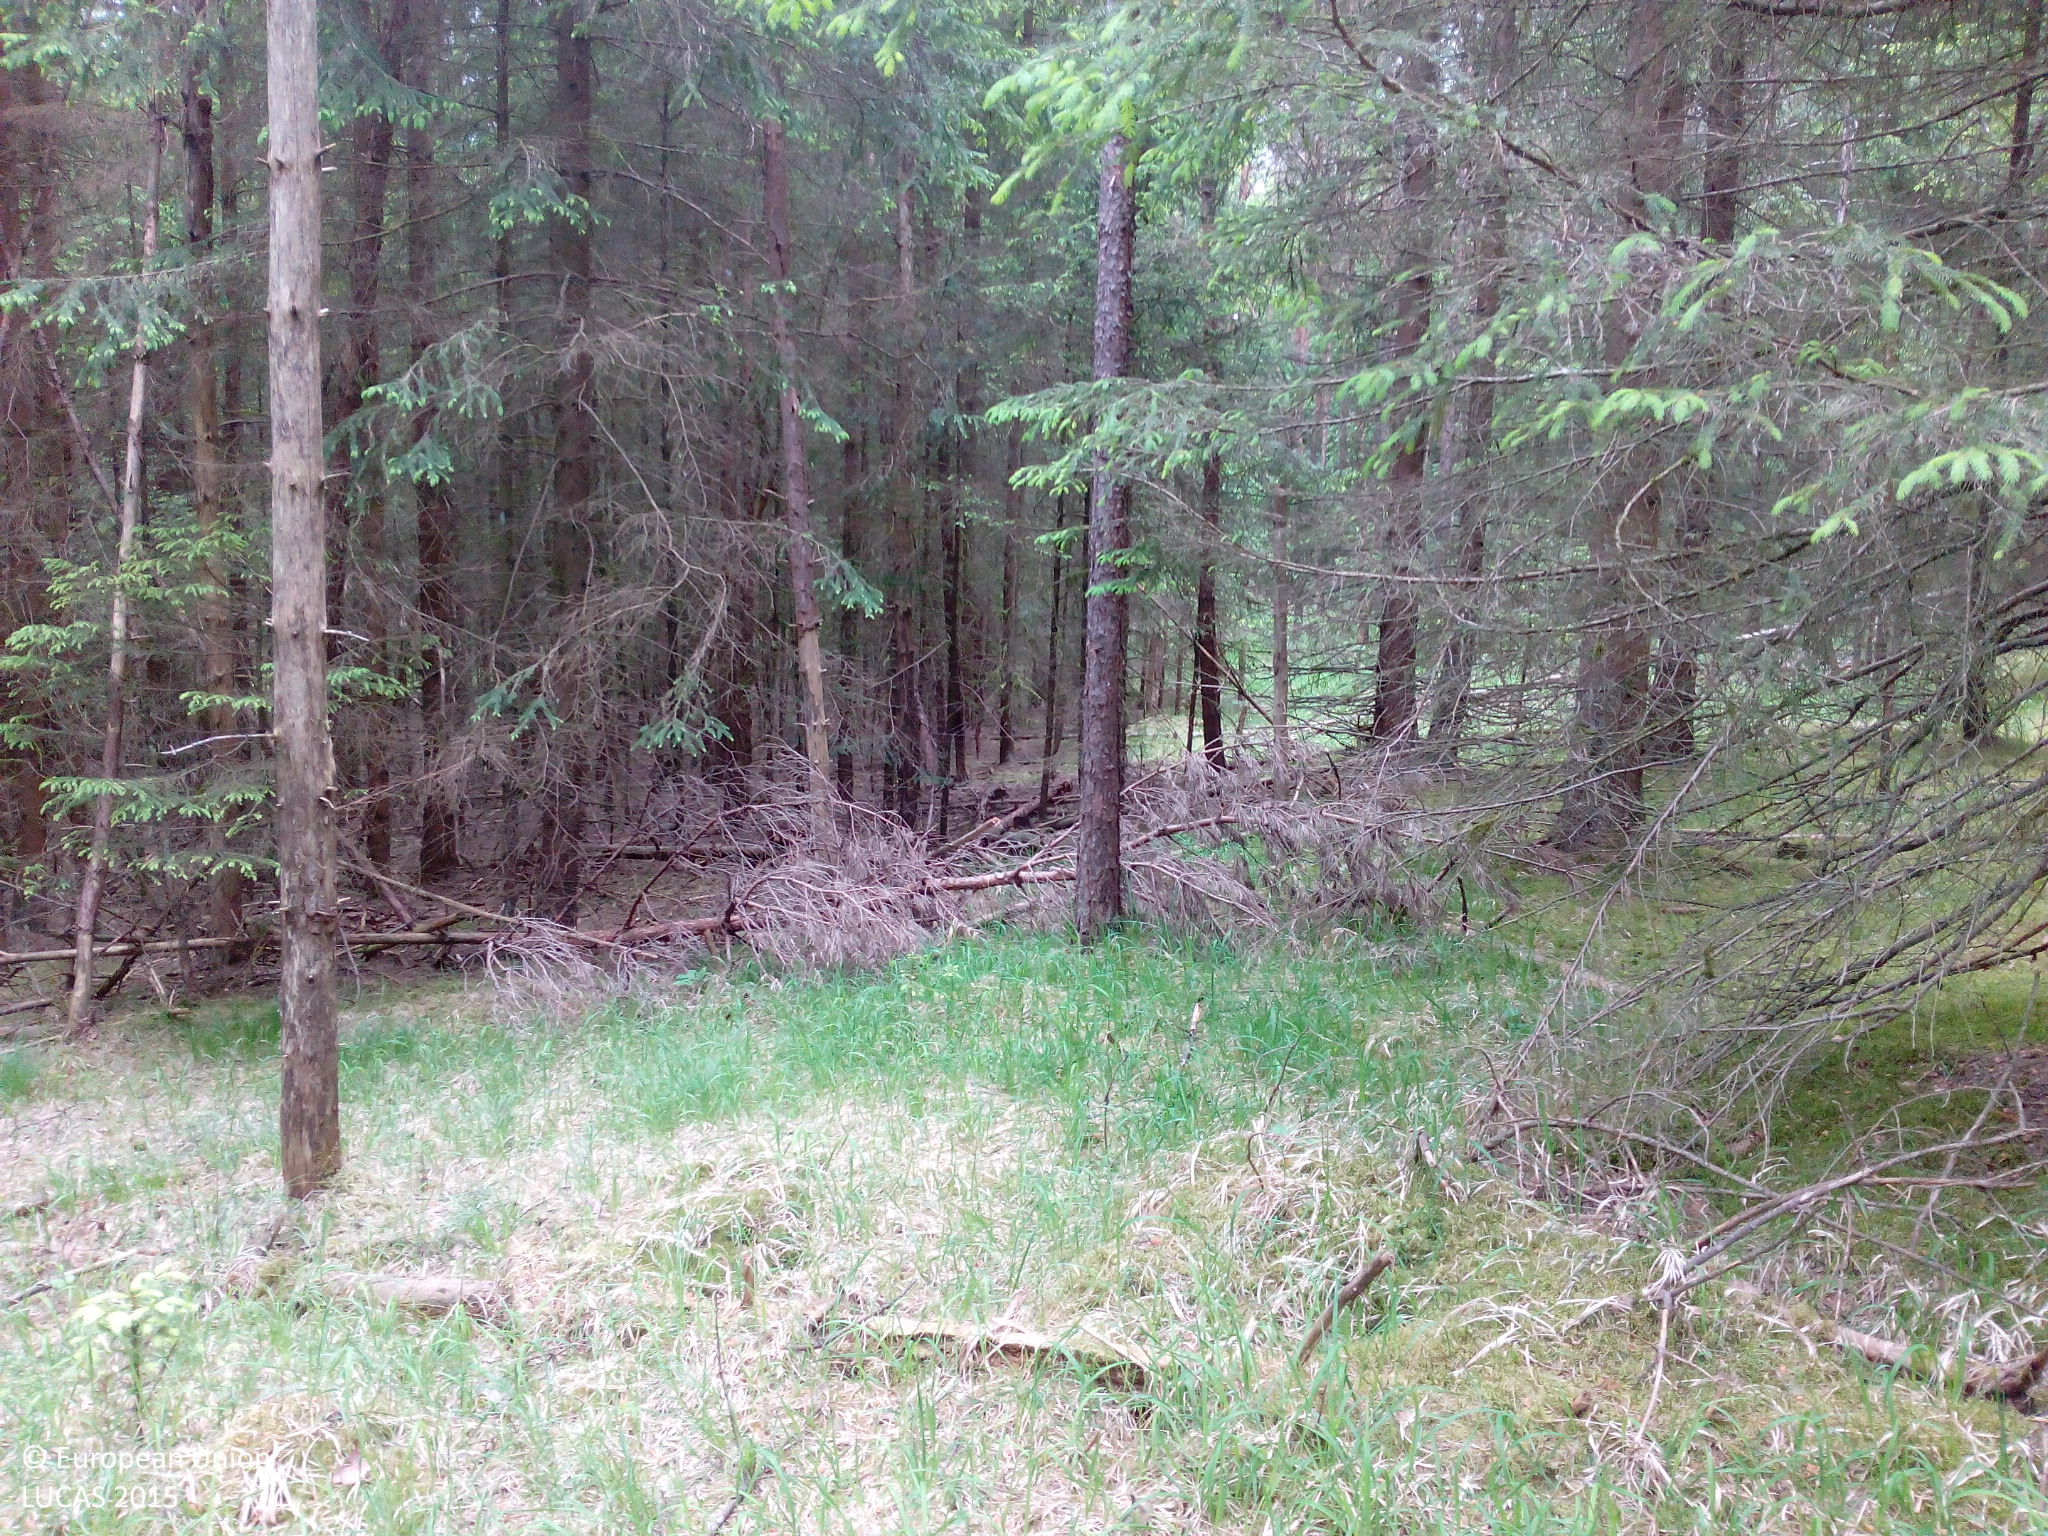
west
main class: Woodland
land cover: Other coniferous woodland
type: hemiboreal forest and nemoral coniferous forest and mixed broadleaved-coniferous forest
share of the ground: 50 - 75 %
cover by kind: coniferous forest trees 60 %, herbaceous plants 40 %
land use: Forestry
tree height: > 5 m
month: May
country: DE
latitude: 49.7609
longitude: 11.4850
